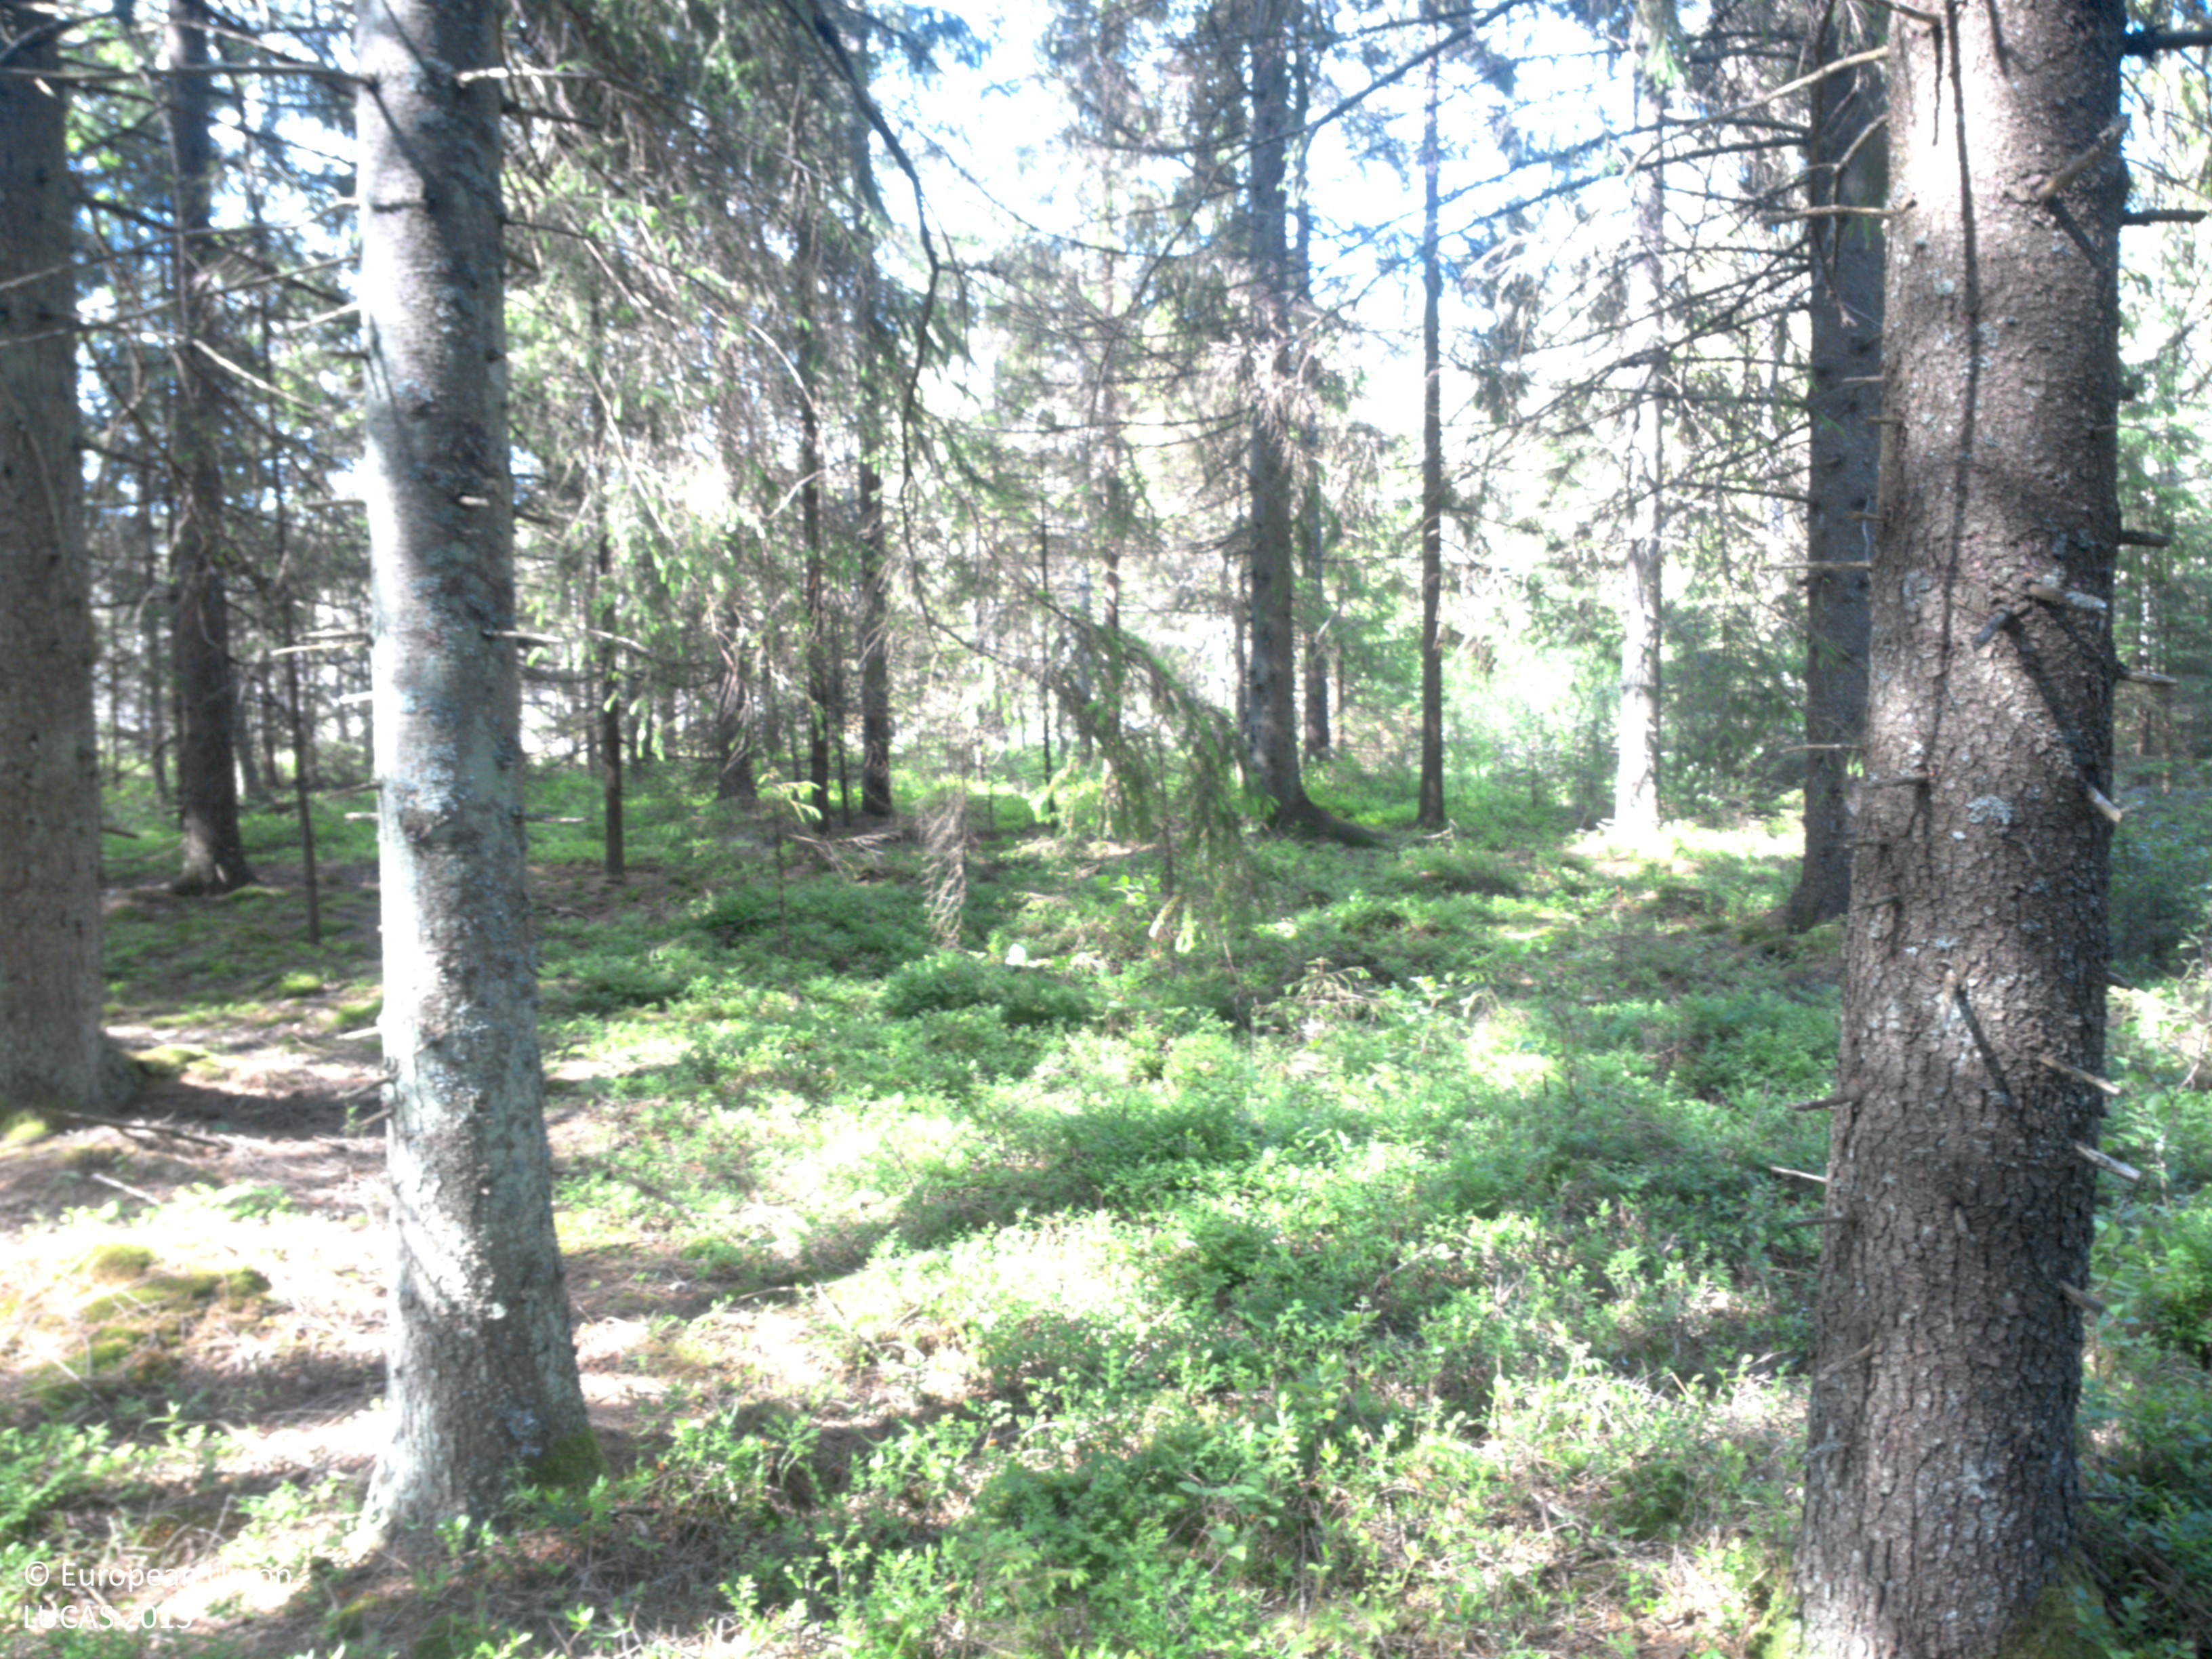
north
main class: Woodland
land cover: Spruce dominated coniferous woodland
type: boreal forest
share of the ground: 50 - 75 %
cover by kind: coniferous forest trees 55 %, shrubs 25 %, herbaceous plants 10 %, broadleaved forest trees 5 %, lichens and mosses 5 %
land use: Forestry
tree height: > 5 m
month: June
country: SE
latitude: 58.5514
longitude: 11.6290
